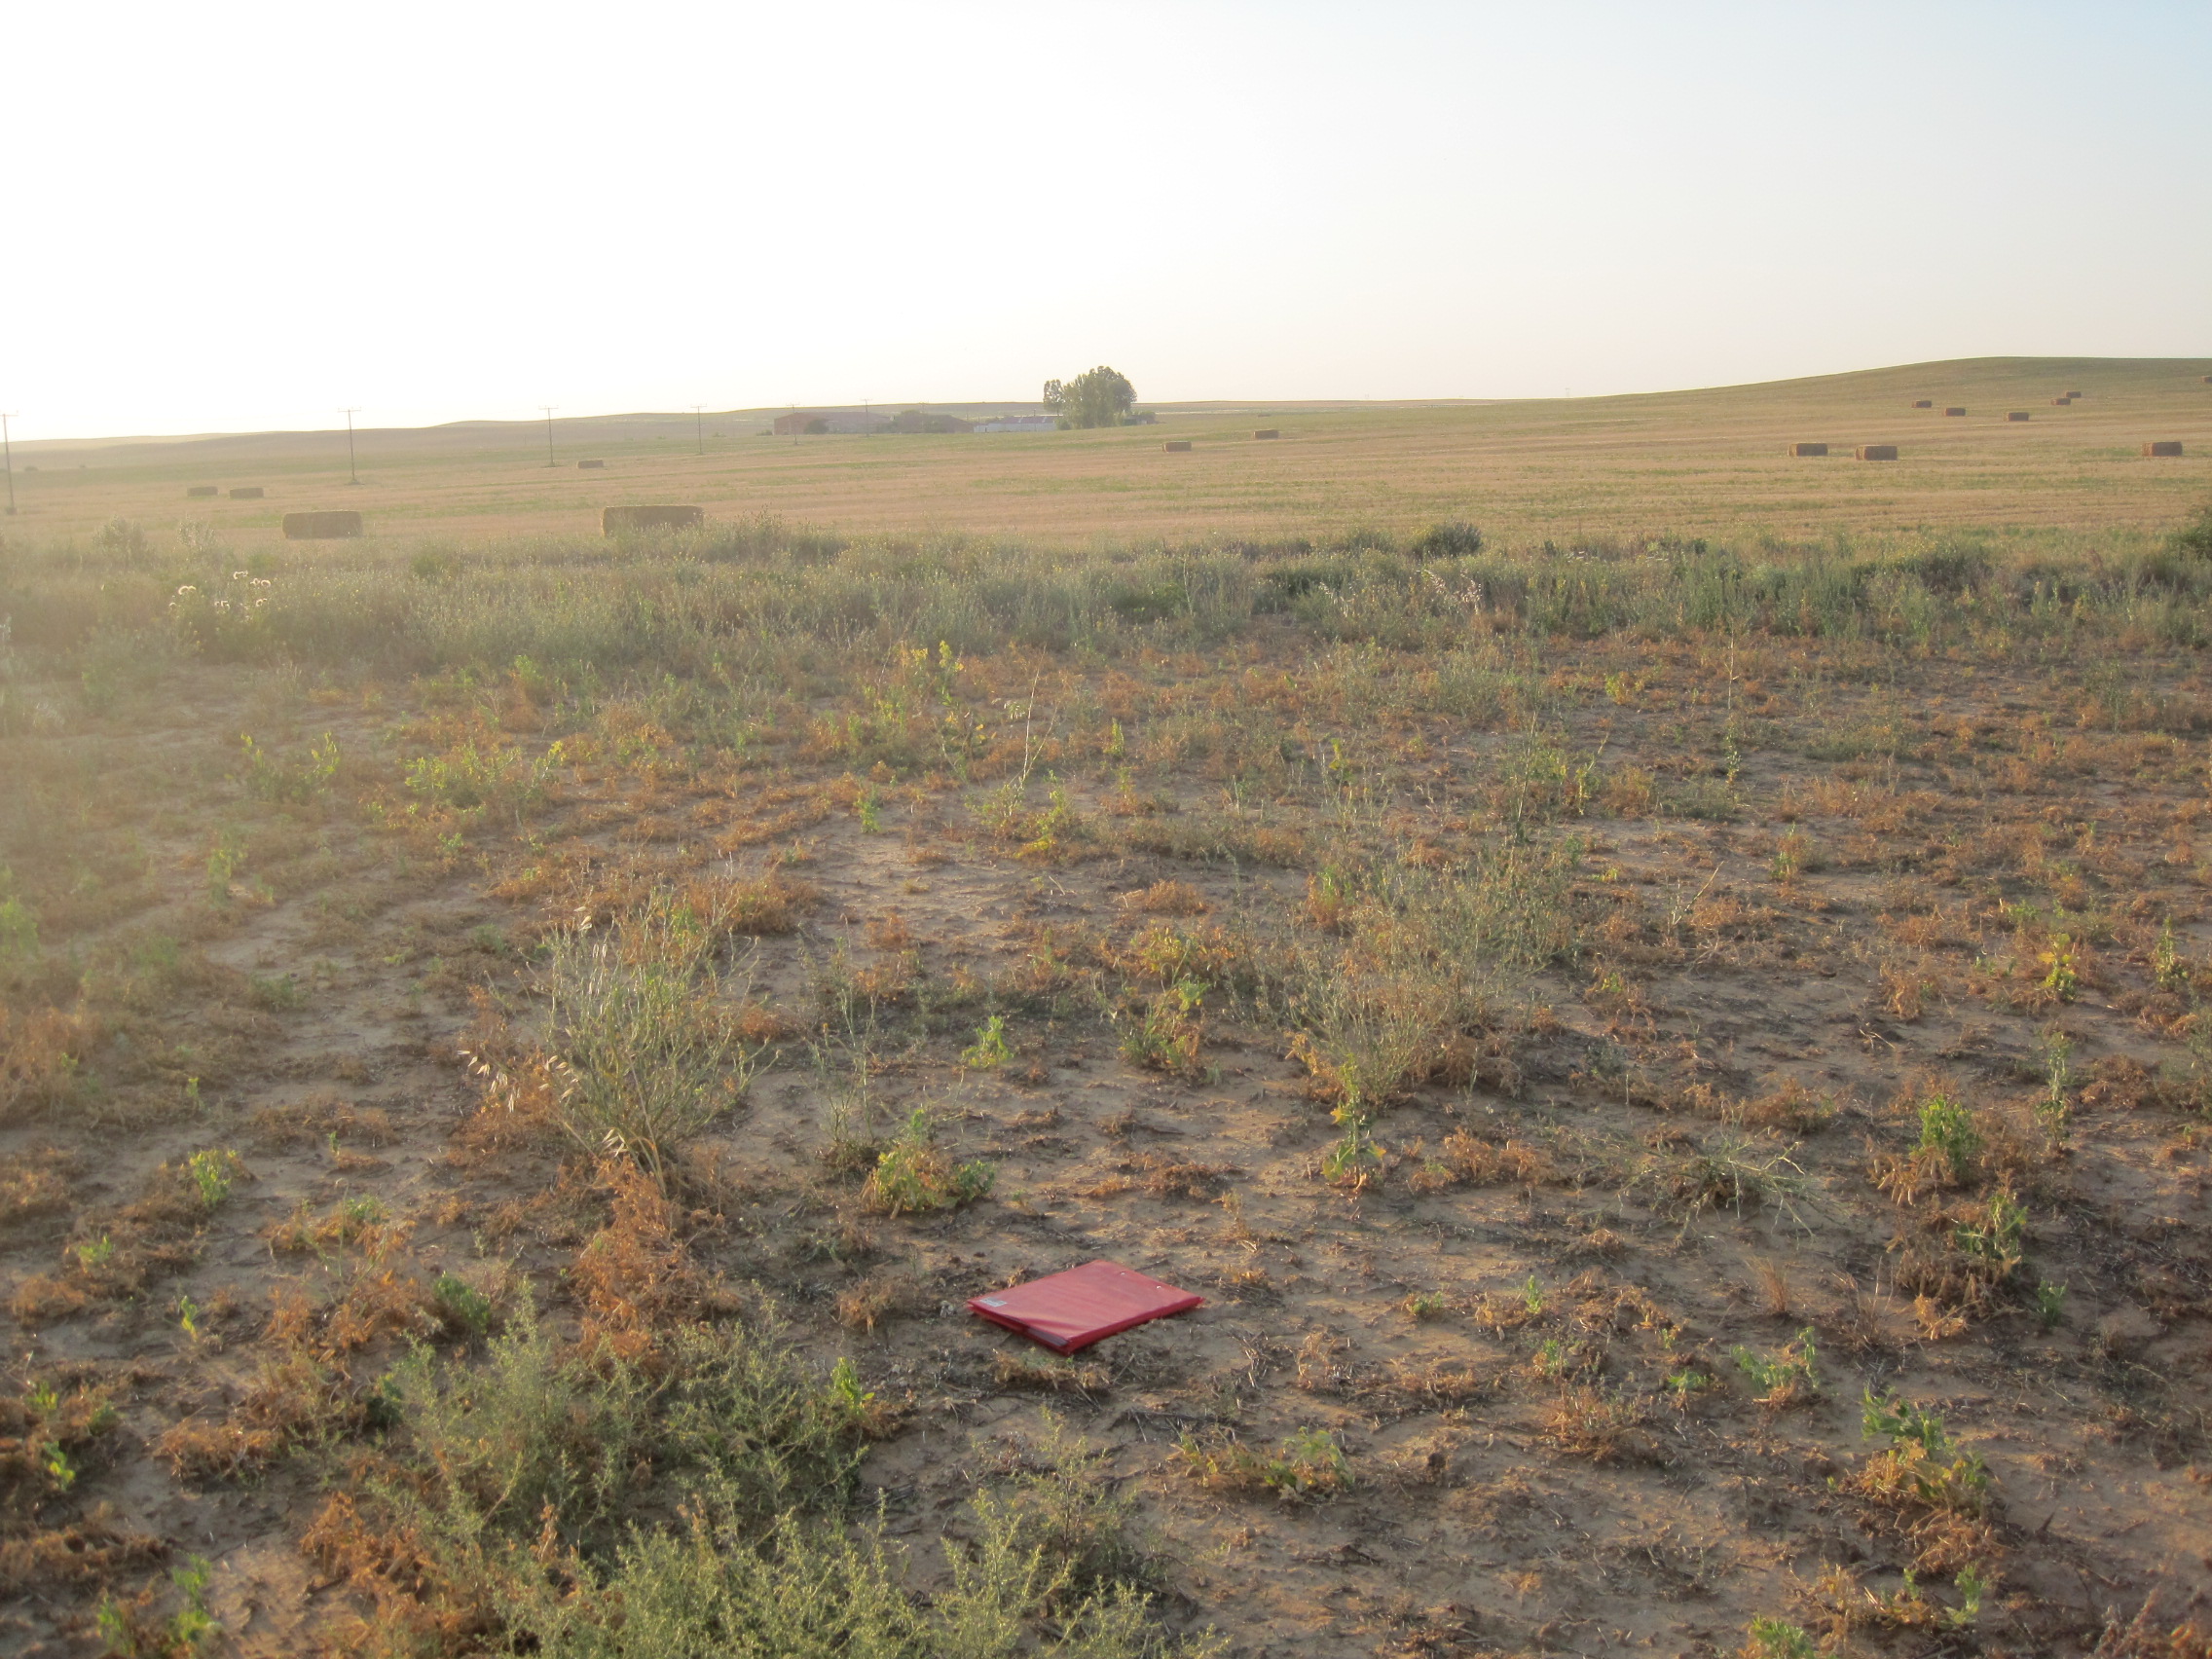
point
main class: Cropland
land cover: Dry pulses
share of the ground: 25 - 50 %
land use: Agriculture (excluding fallow land and kitchen gardens)
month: July
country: ES
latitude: 41.8909
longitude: -5.1574
